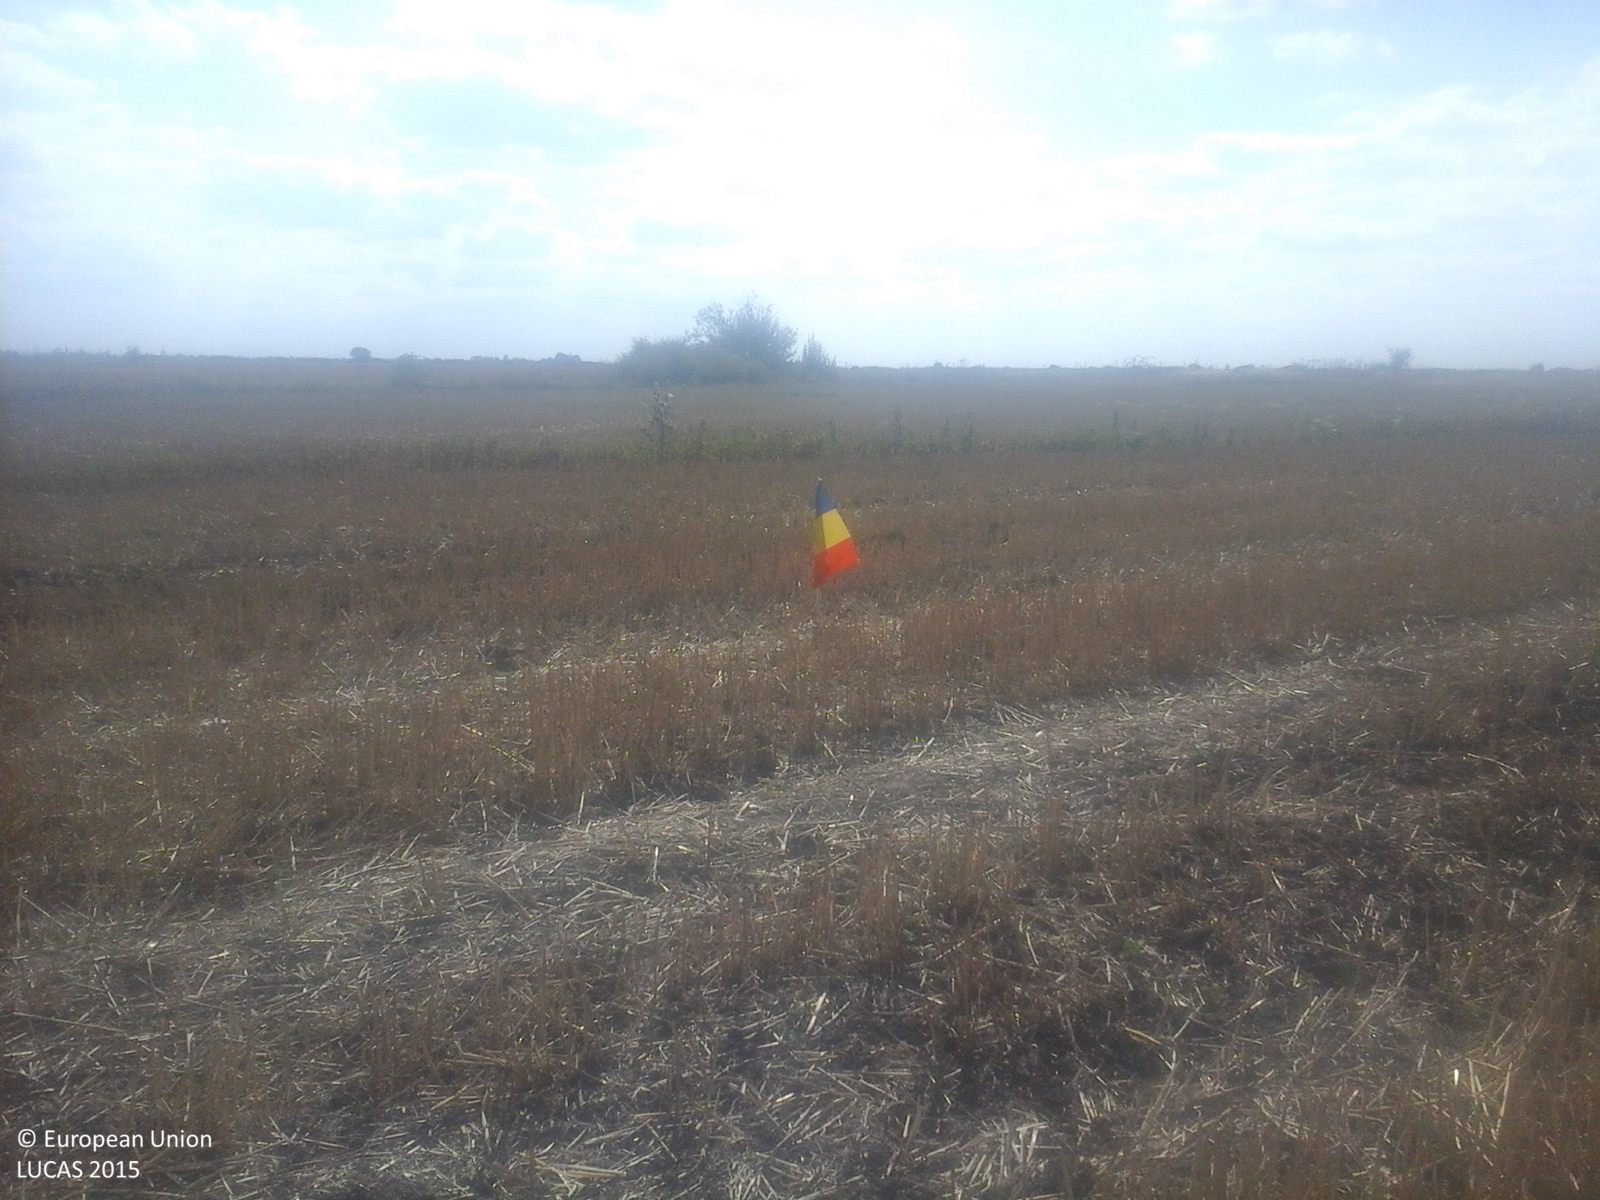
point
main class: Cropland
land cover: Common wheat
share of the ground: < 10 %
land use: Agriculture (excluding fallow land and kitchen gardens)
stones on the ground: < 10 %
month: September
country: RO
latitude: 47.6469
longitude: 22.7213
